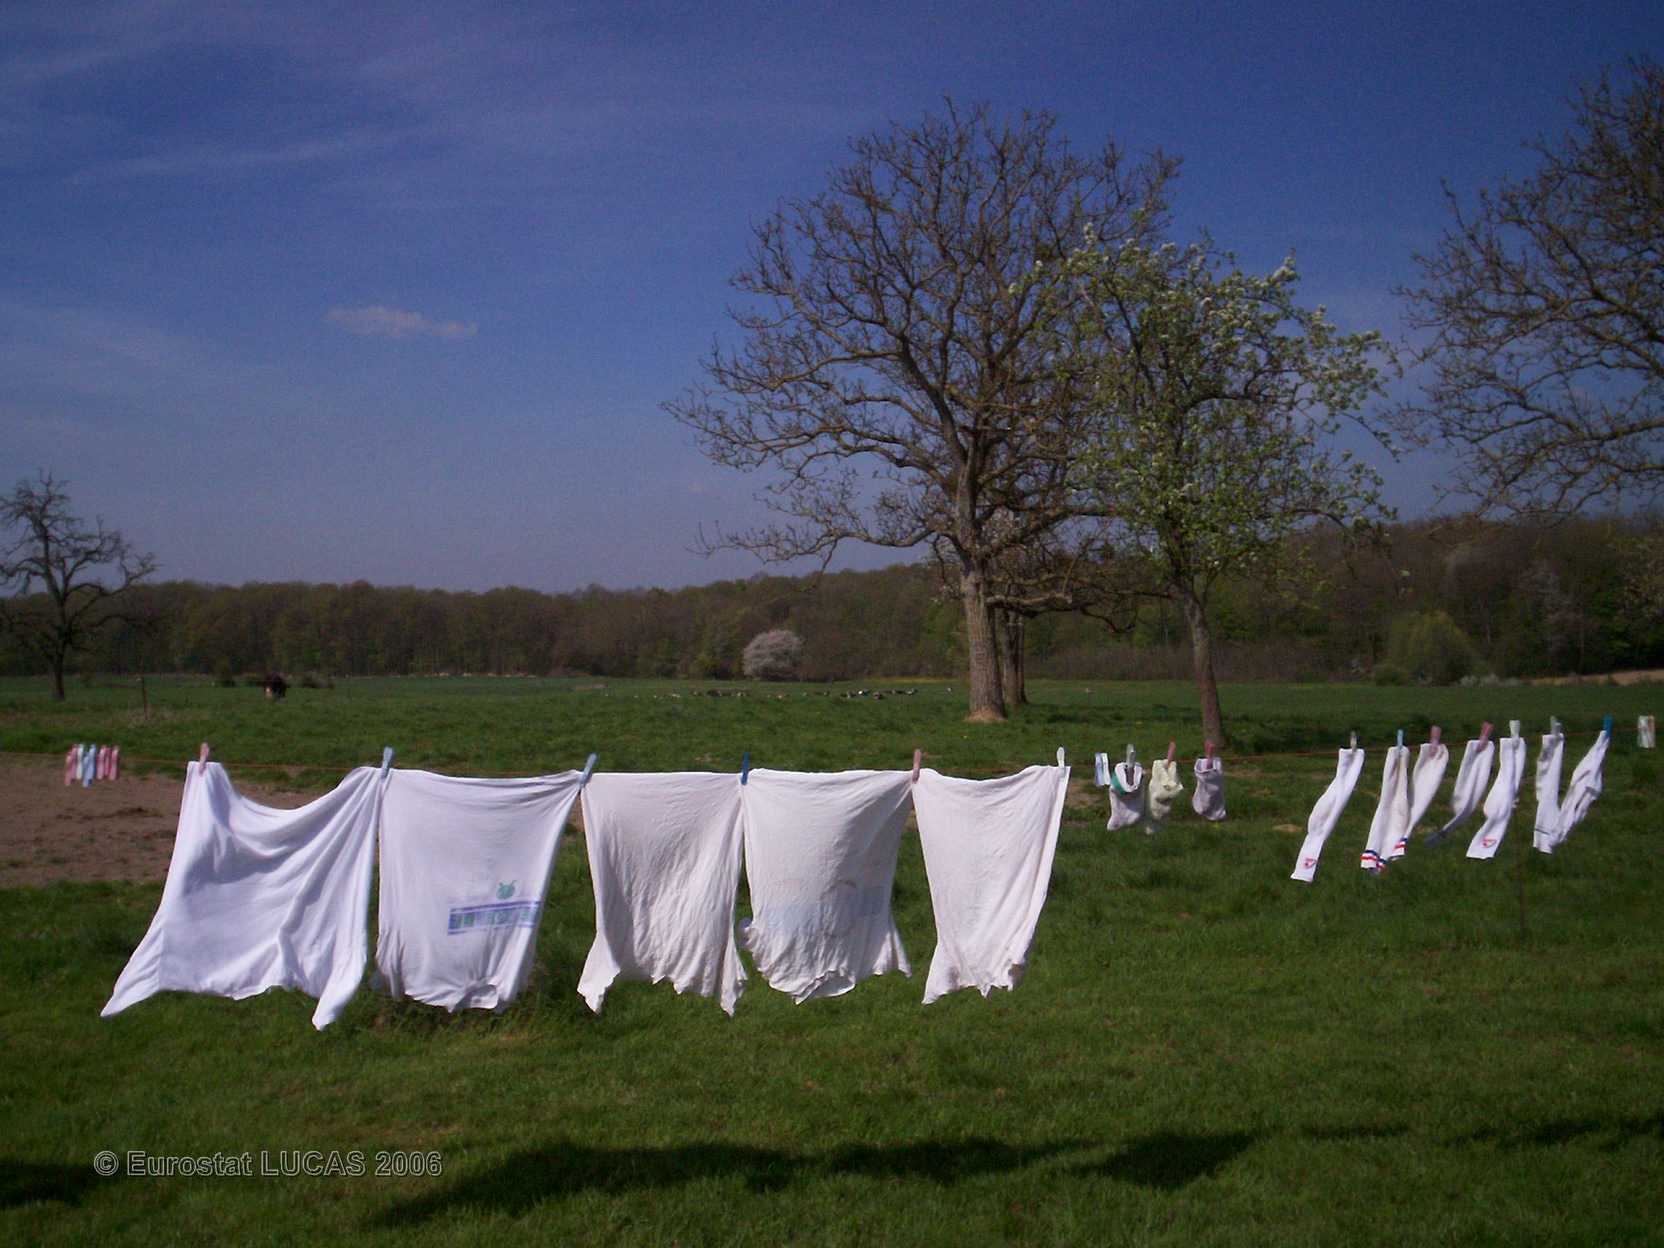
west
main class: Grassland
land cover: Grassland with sparse tree/shrub cover
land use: Residential
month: April
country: FR
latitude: 49.6328
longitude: 4.4162
